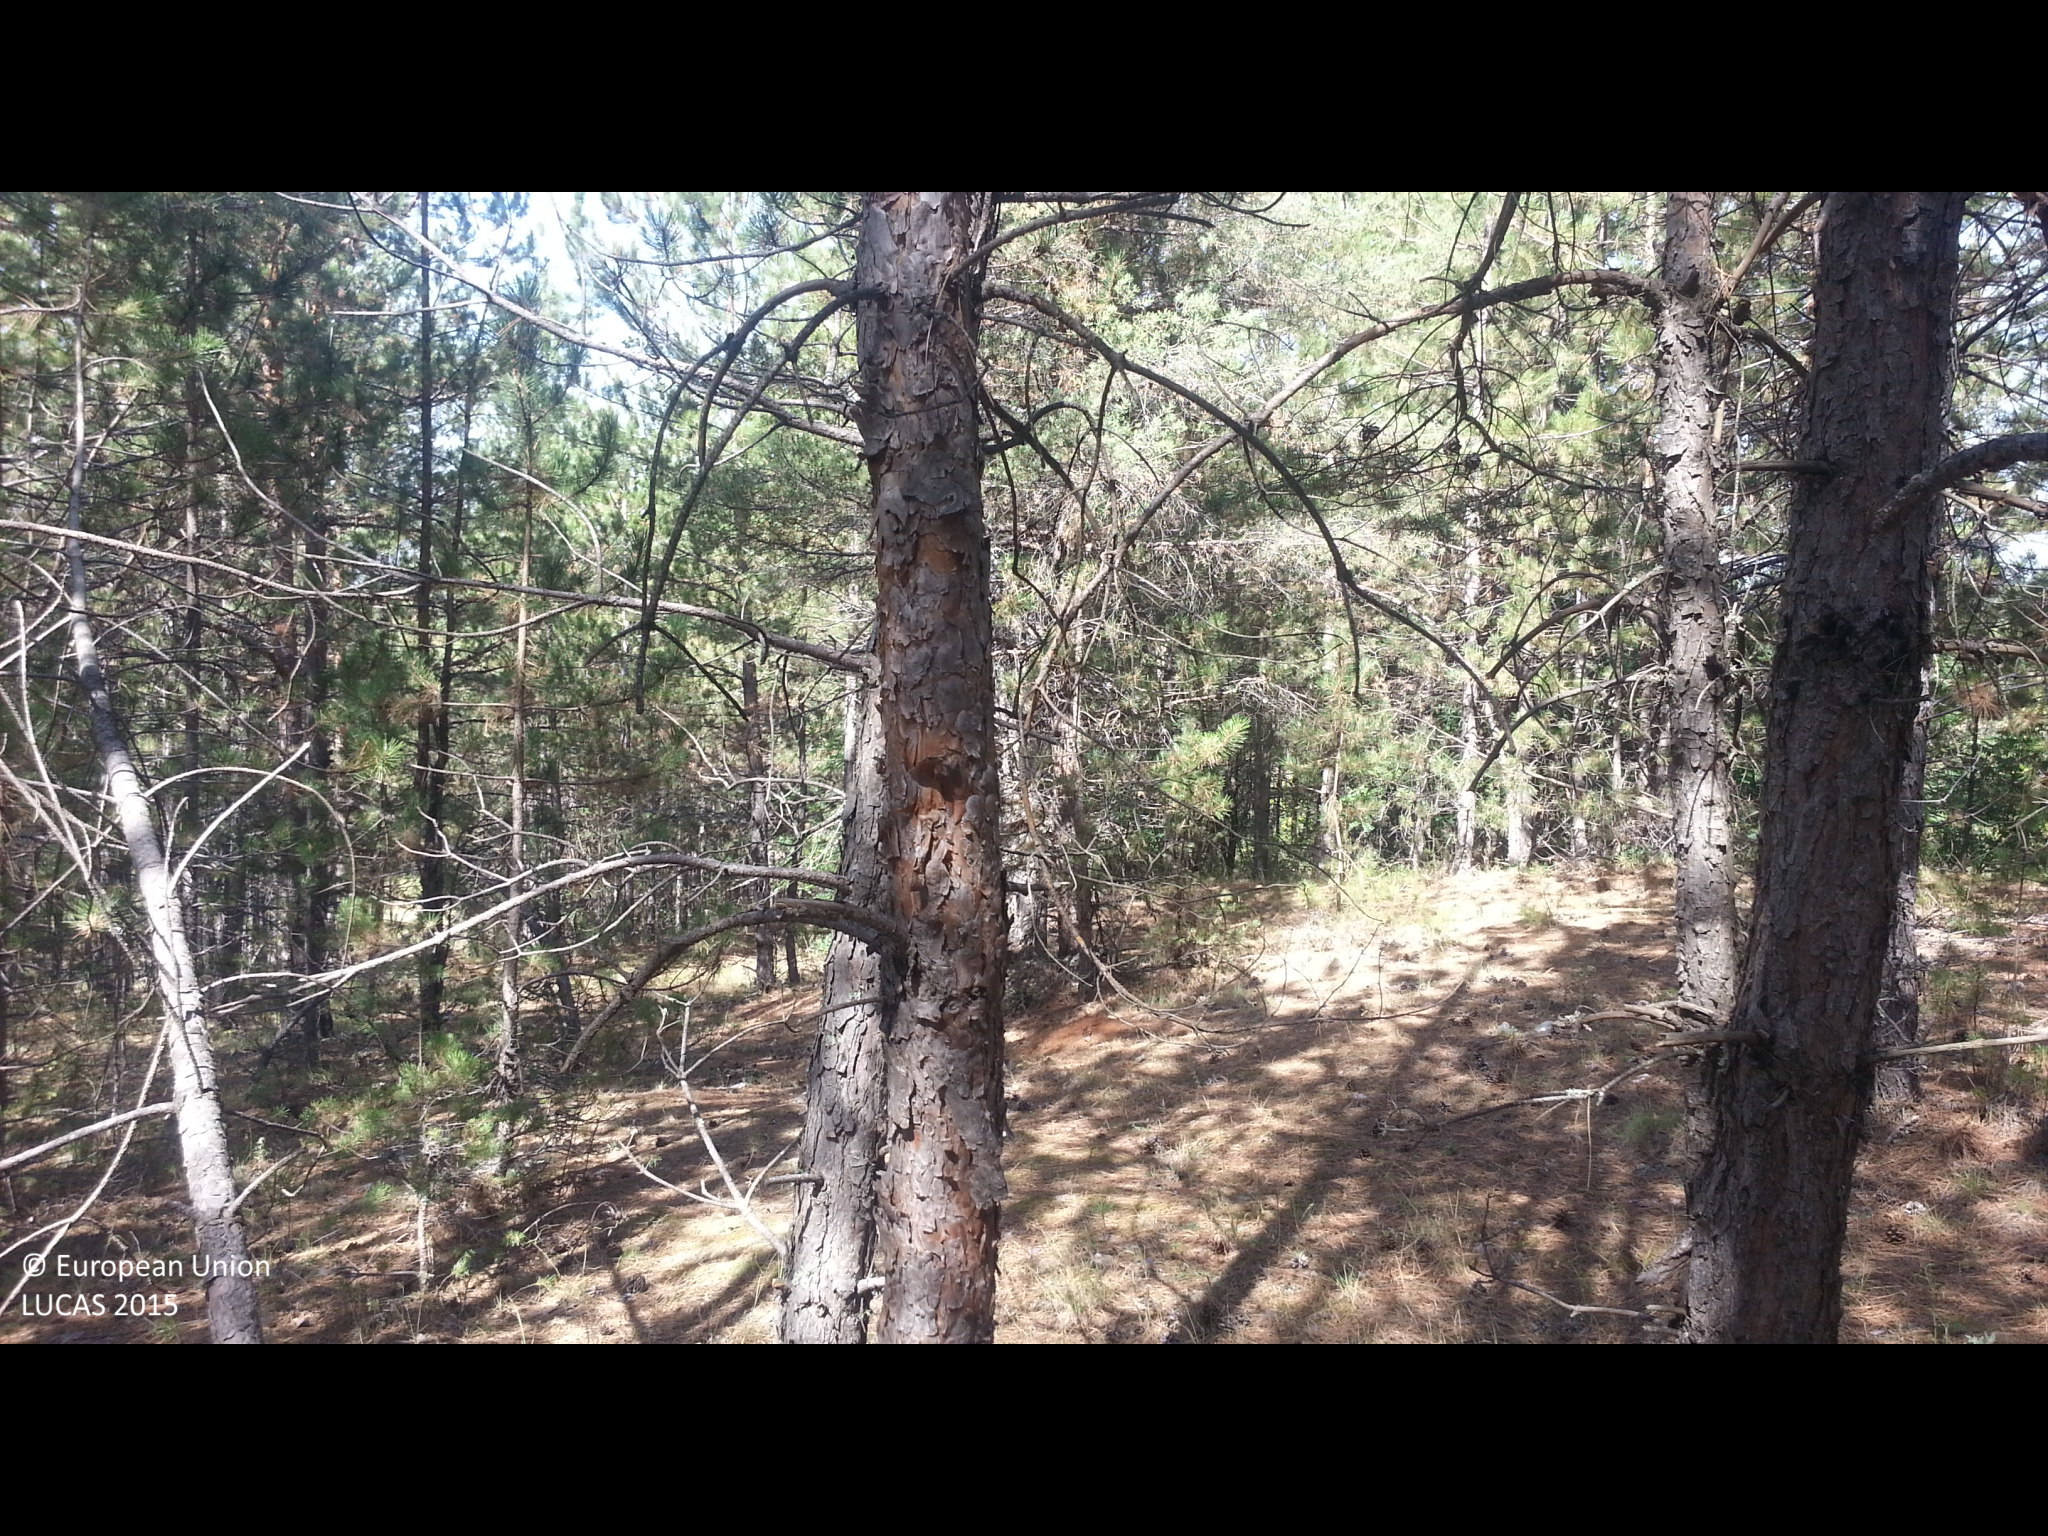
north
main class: Woodland
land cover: Pine dominated coniferous woodland
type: hemiboreal forest and nemoral coniferous forest and mixed broadleaved-coniferous forest
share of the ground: > 75 %
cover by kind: coniferous forest trees 85 %, shrubs 10 %, unconsolidated bare surface 5 %
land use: Forestry
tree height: > 5 m
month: September
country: BG
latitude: 42.1410
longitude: 22.8601
